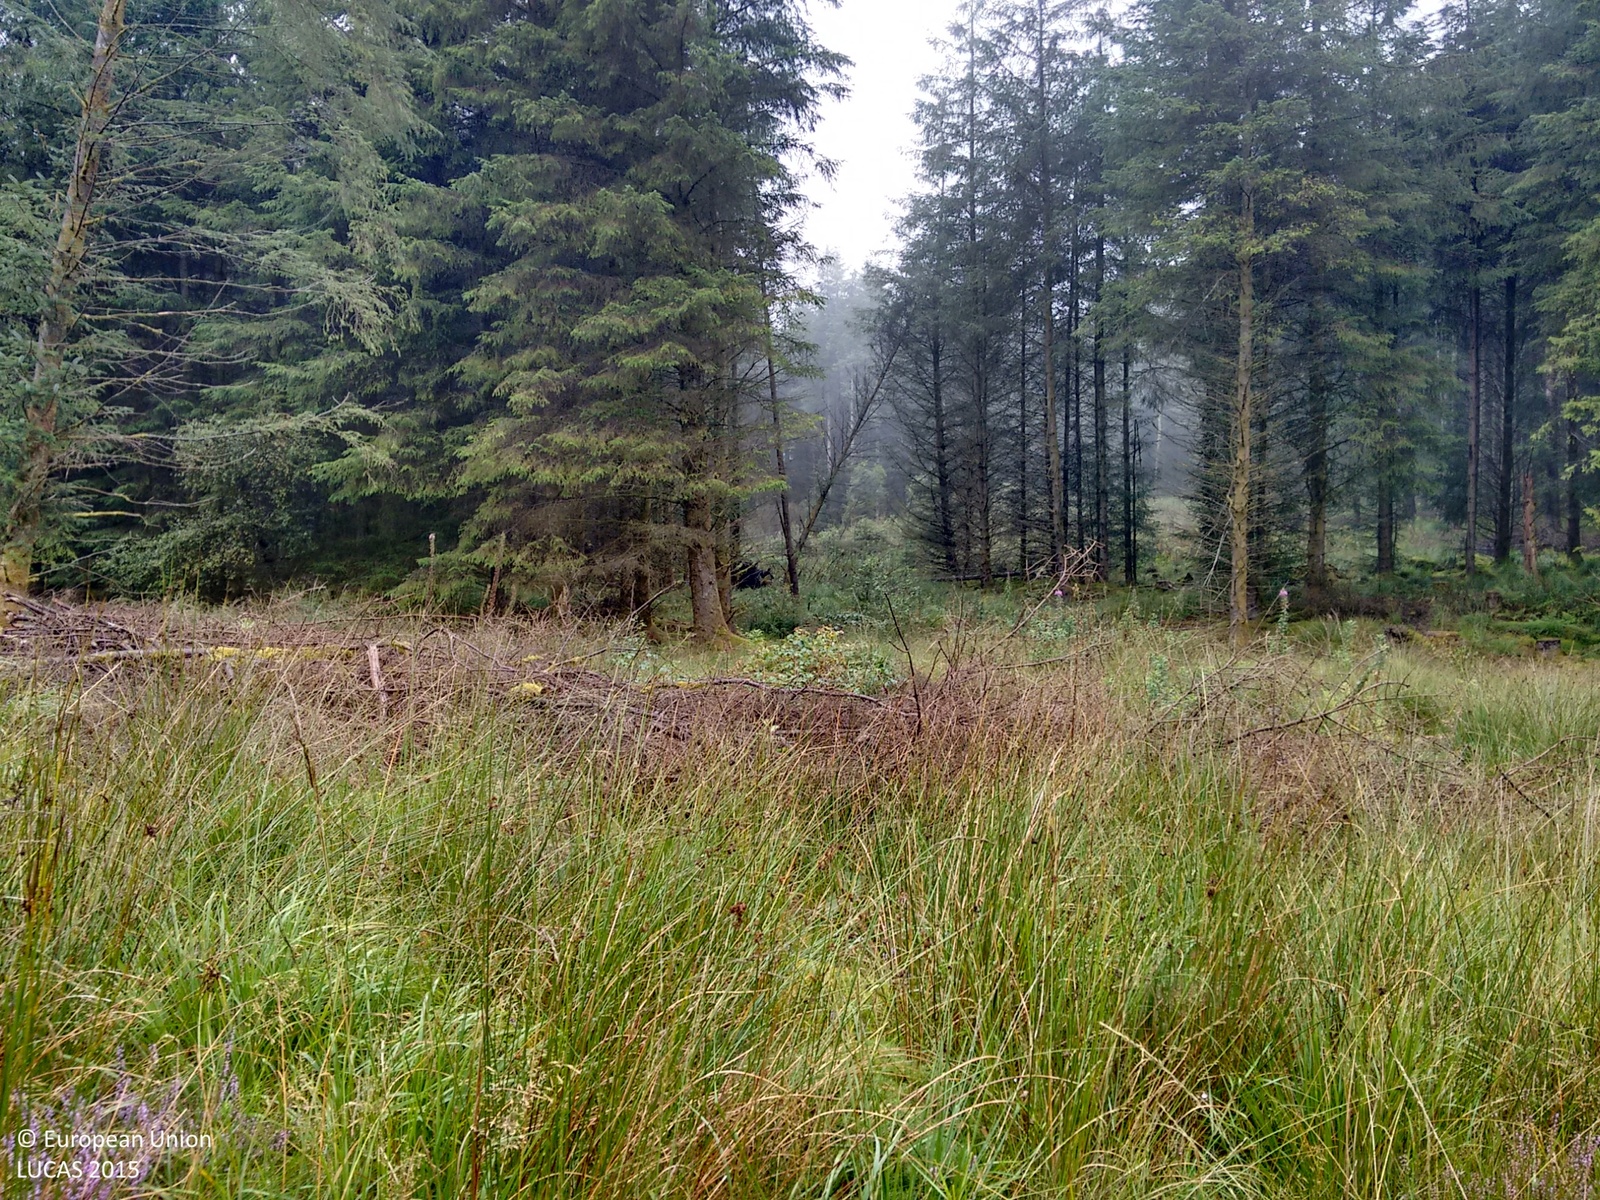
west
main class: Woodland
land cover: Spruce dominated coniferous woodland
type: exotic forest
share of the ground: > 75 %
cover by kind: coniferous forest trees 70 %, shrubs 15 %, herbaceous plants 15 %
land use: Forestry
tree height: > 5 m
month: September
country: GB
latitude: 52.1277
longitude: -3.8369
